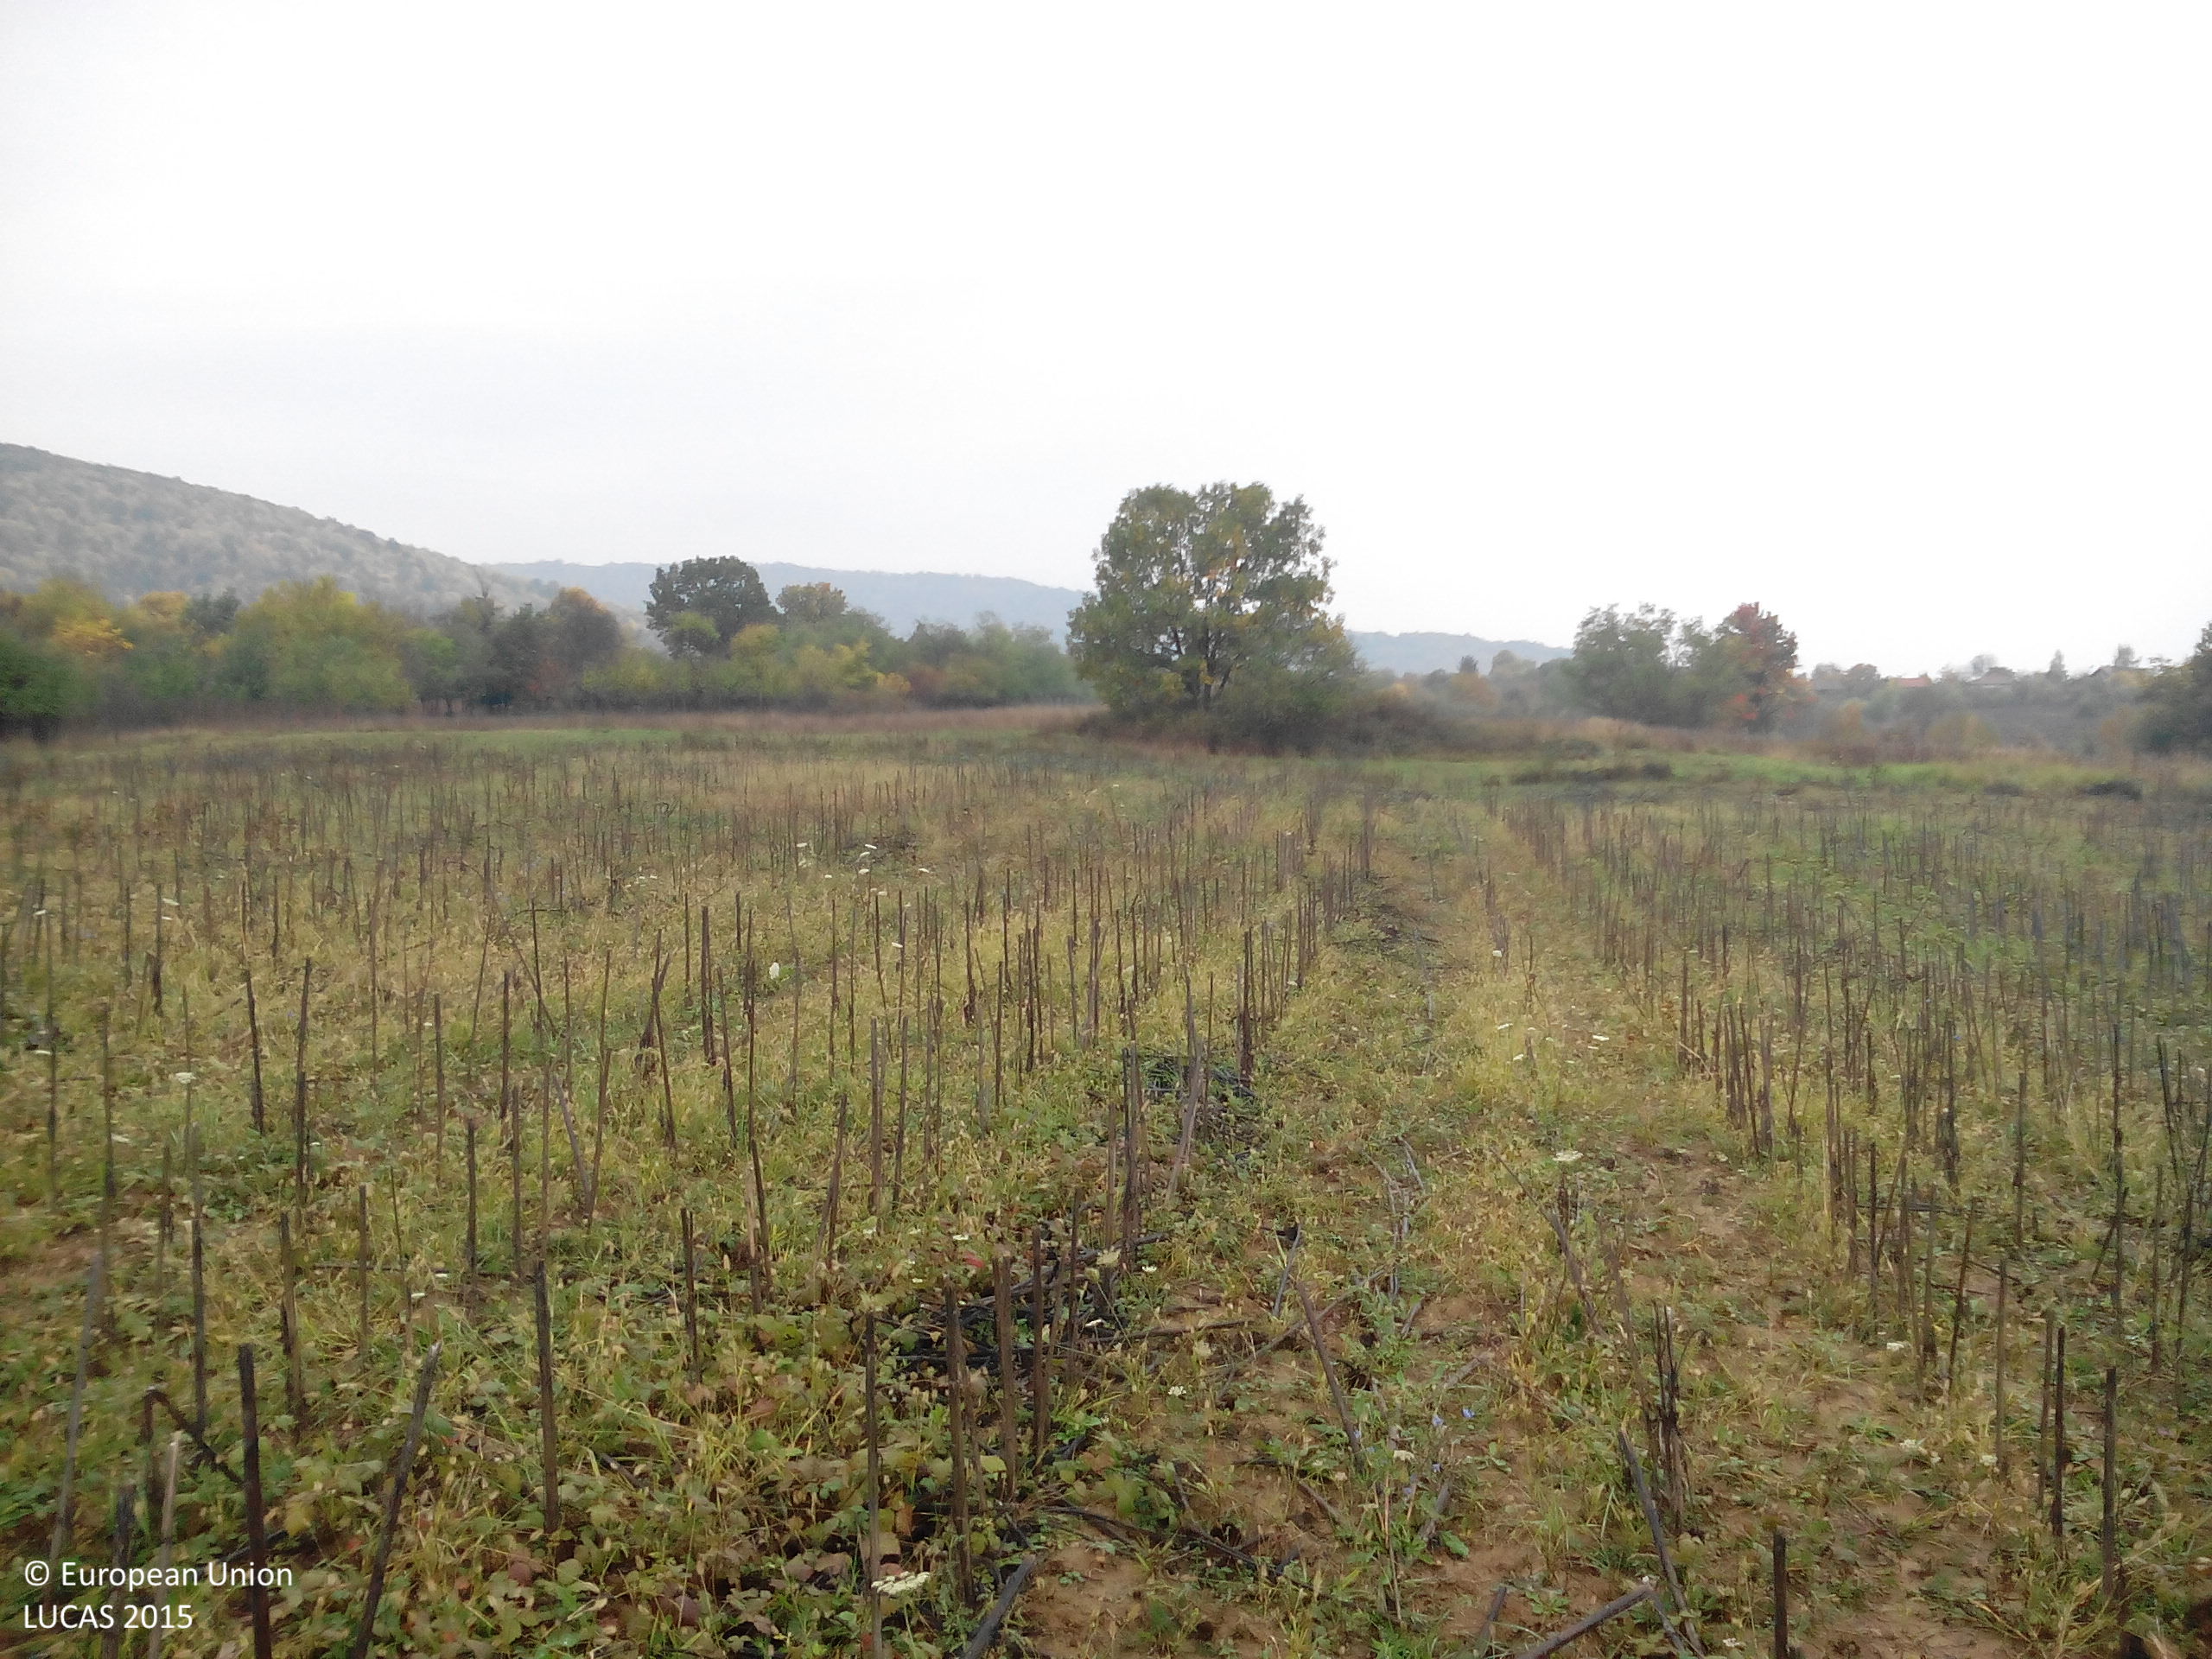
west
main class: Cropland
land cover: Sunflower
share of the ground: 10 - 25 %
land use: Agriculture (excluding fallow land and kitchen gardens)
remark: Harvested field
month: October
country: BG
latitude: 43.0831
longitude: 24.0150
